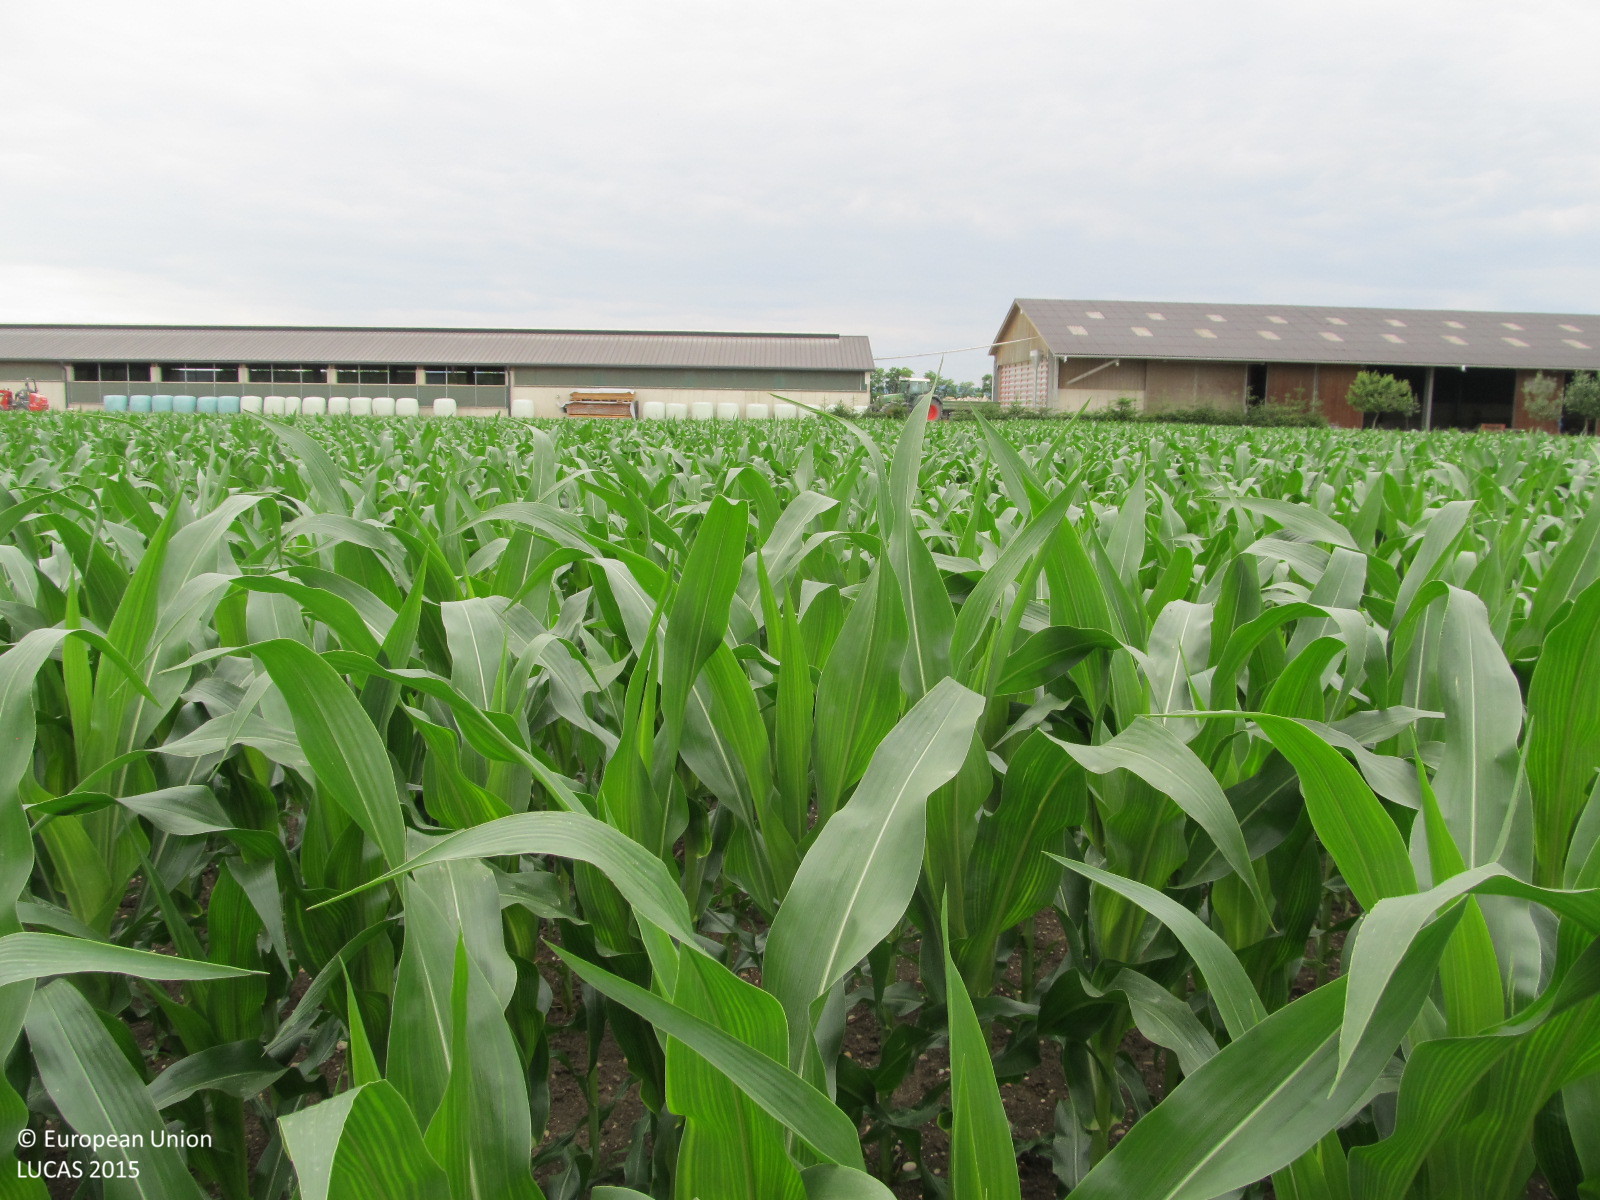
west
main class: Cropland
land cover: Maize
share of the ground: 50 - 75 %
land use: Agriculture (excluding fallow land and kitchen gardens)
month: June
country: AT
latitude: 48.3391
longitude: 15.8451
